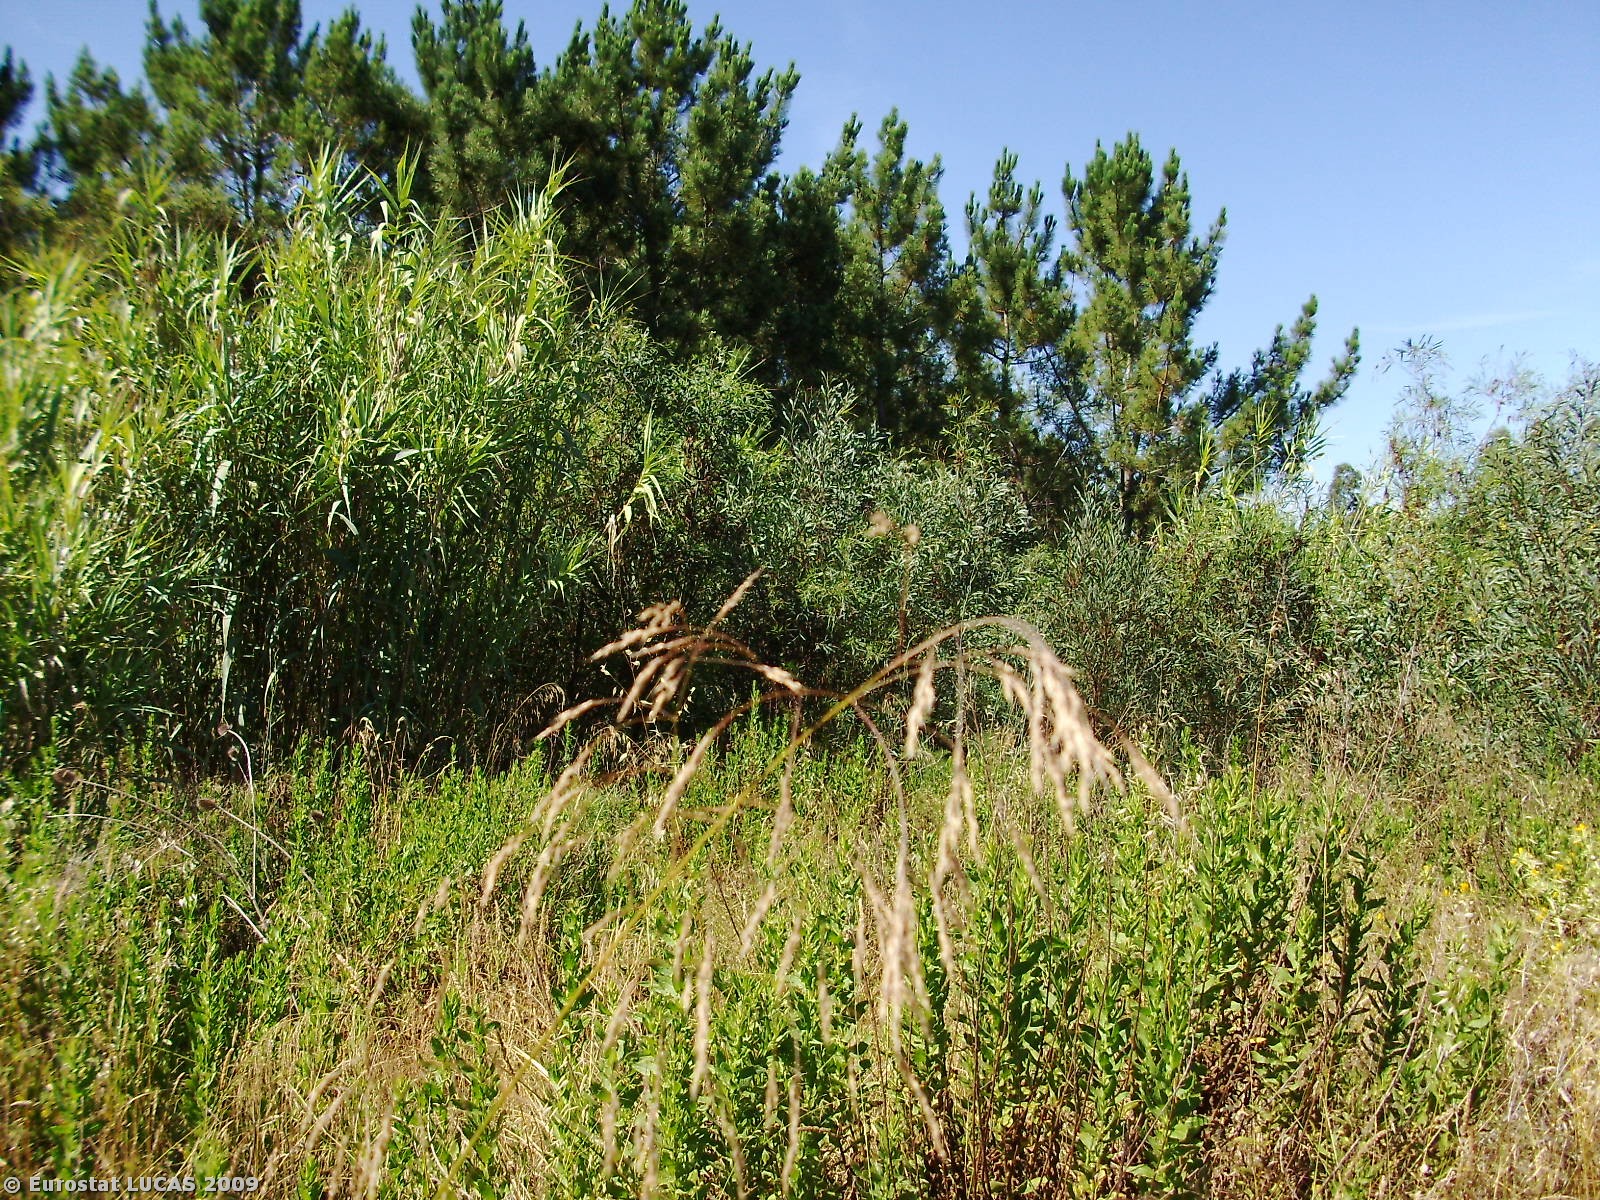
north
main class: Shrubland
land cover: Shrubland with sparse tree cover
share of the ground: > 75 %
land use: Telecommunication
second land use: Fallow land
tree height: > 5 m
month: July
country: PT
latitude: 39.6680
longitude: -8.9136
